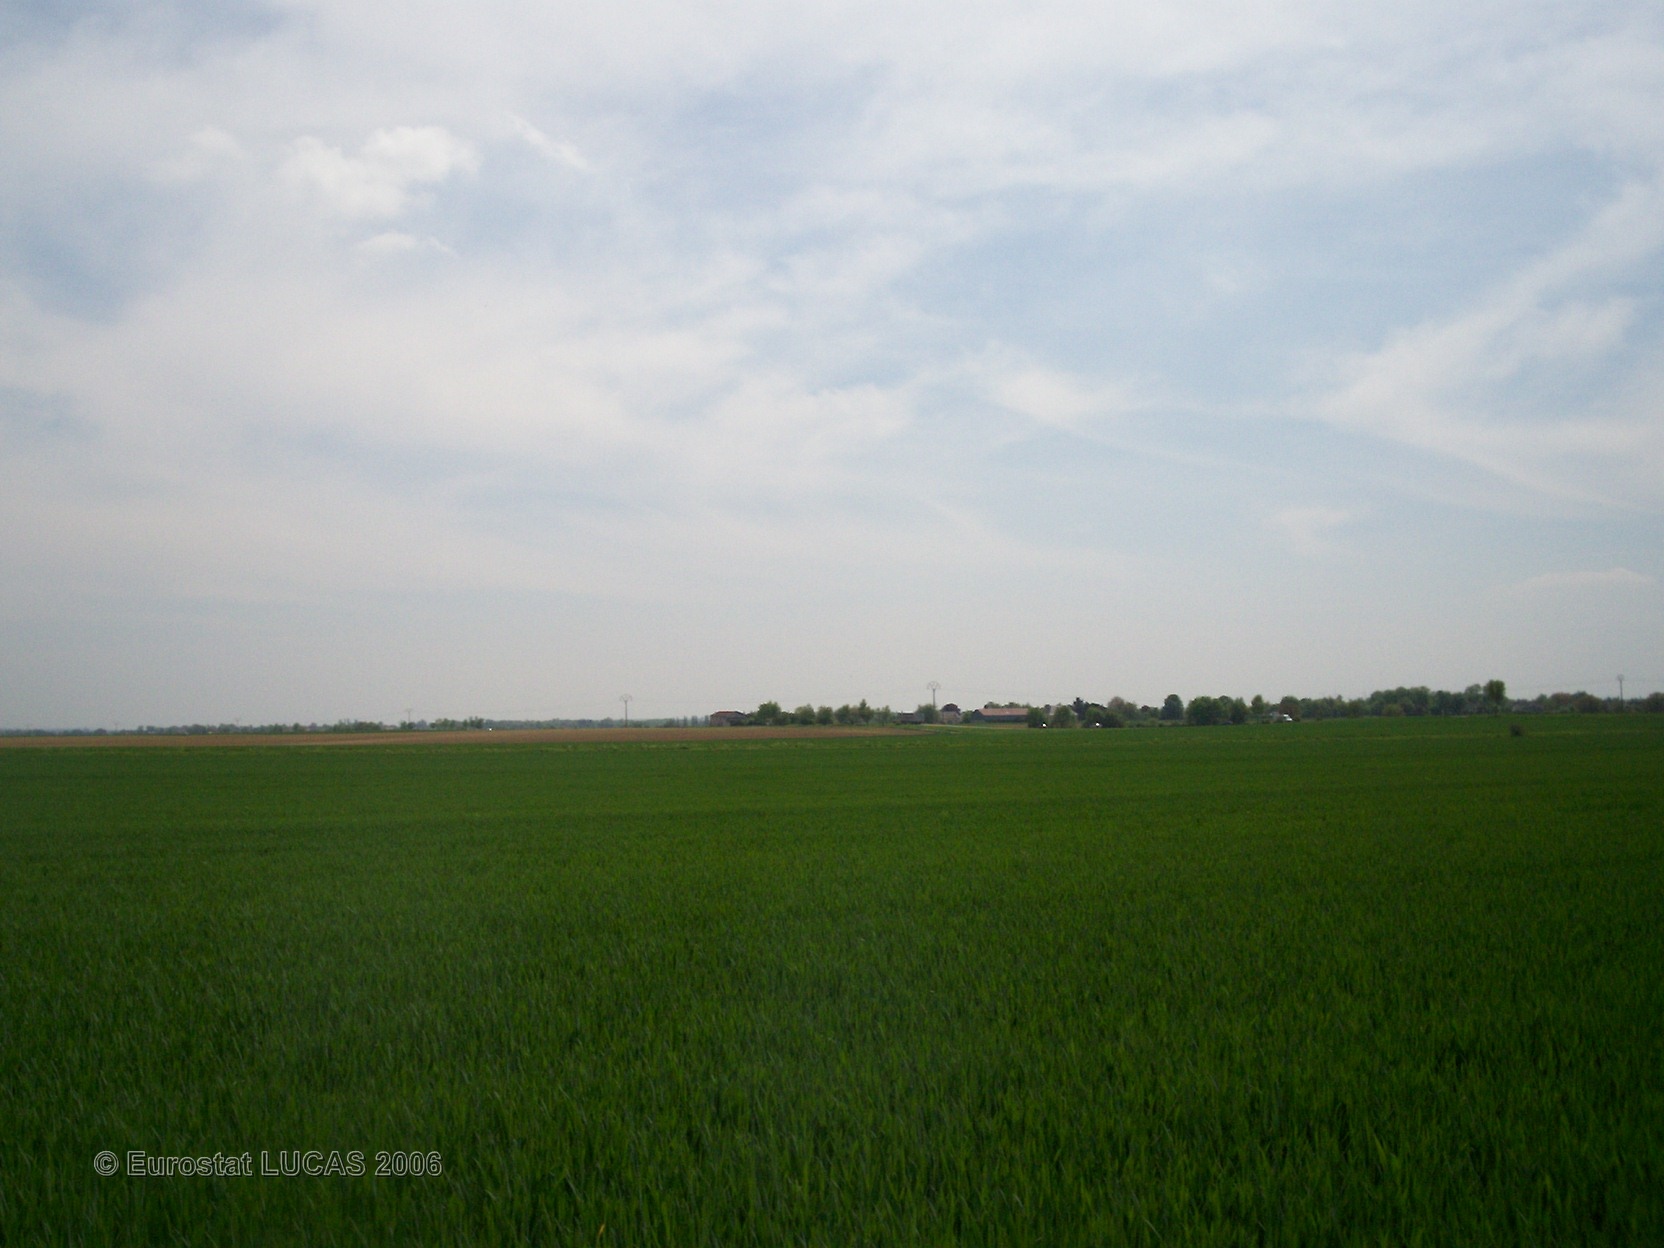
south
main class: Cropland
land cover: Common wheat
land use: Agriculture (excluding fallow land and kitchen gardens)
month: May
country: FR
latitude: 48.9296
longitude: 4.4138
